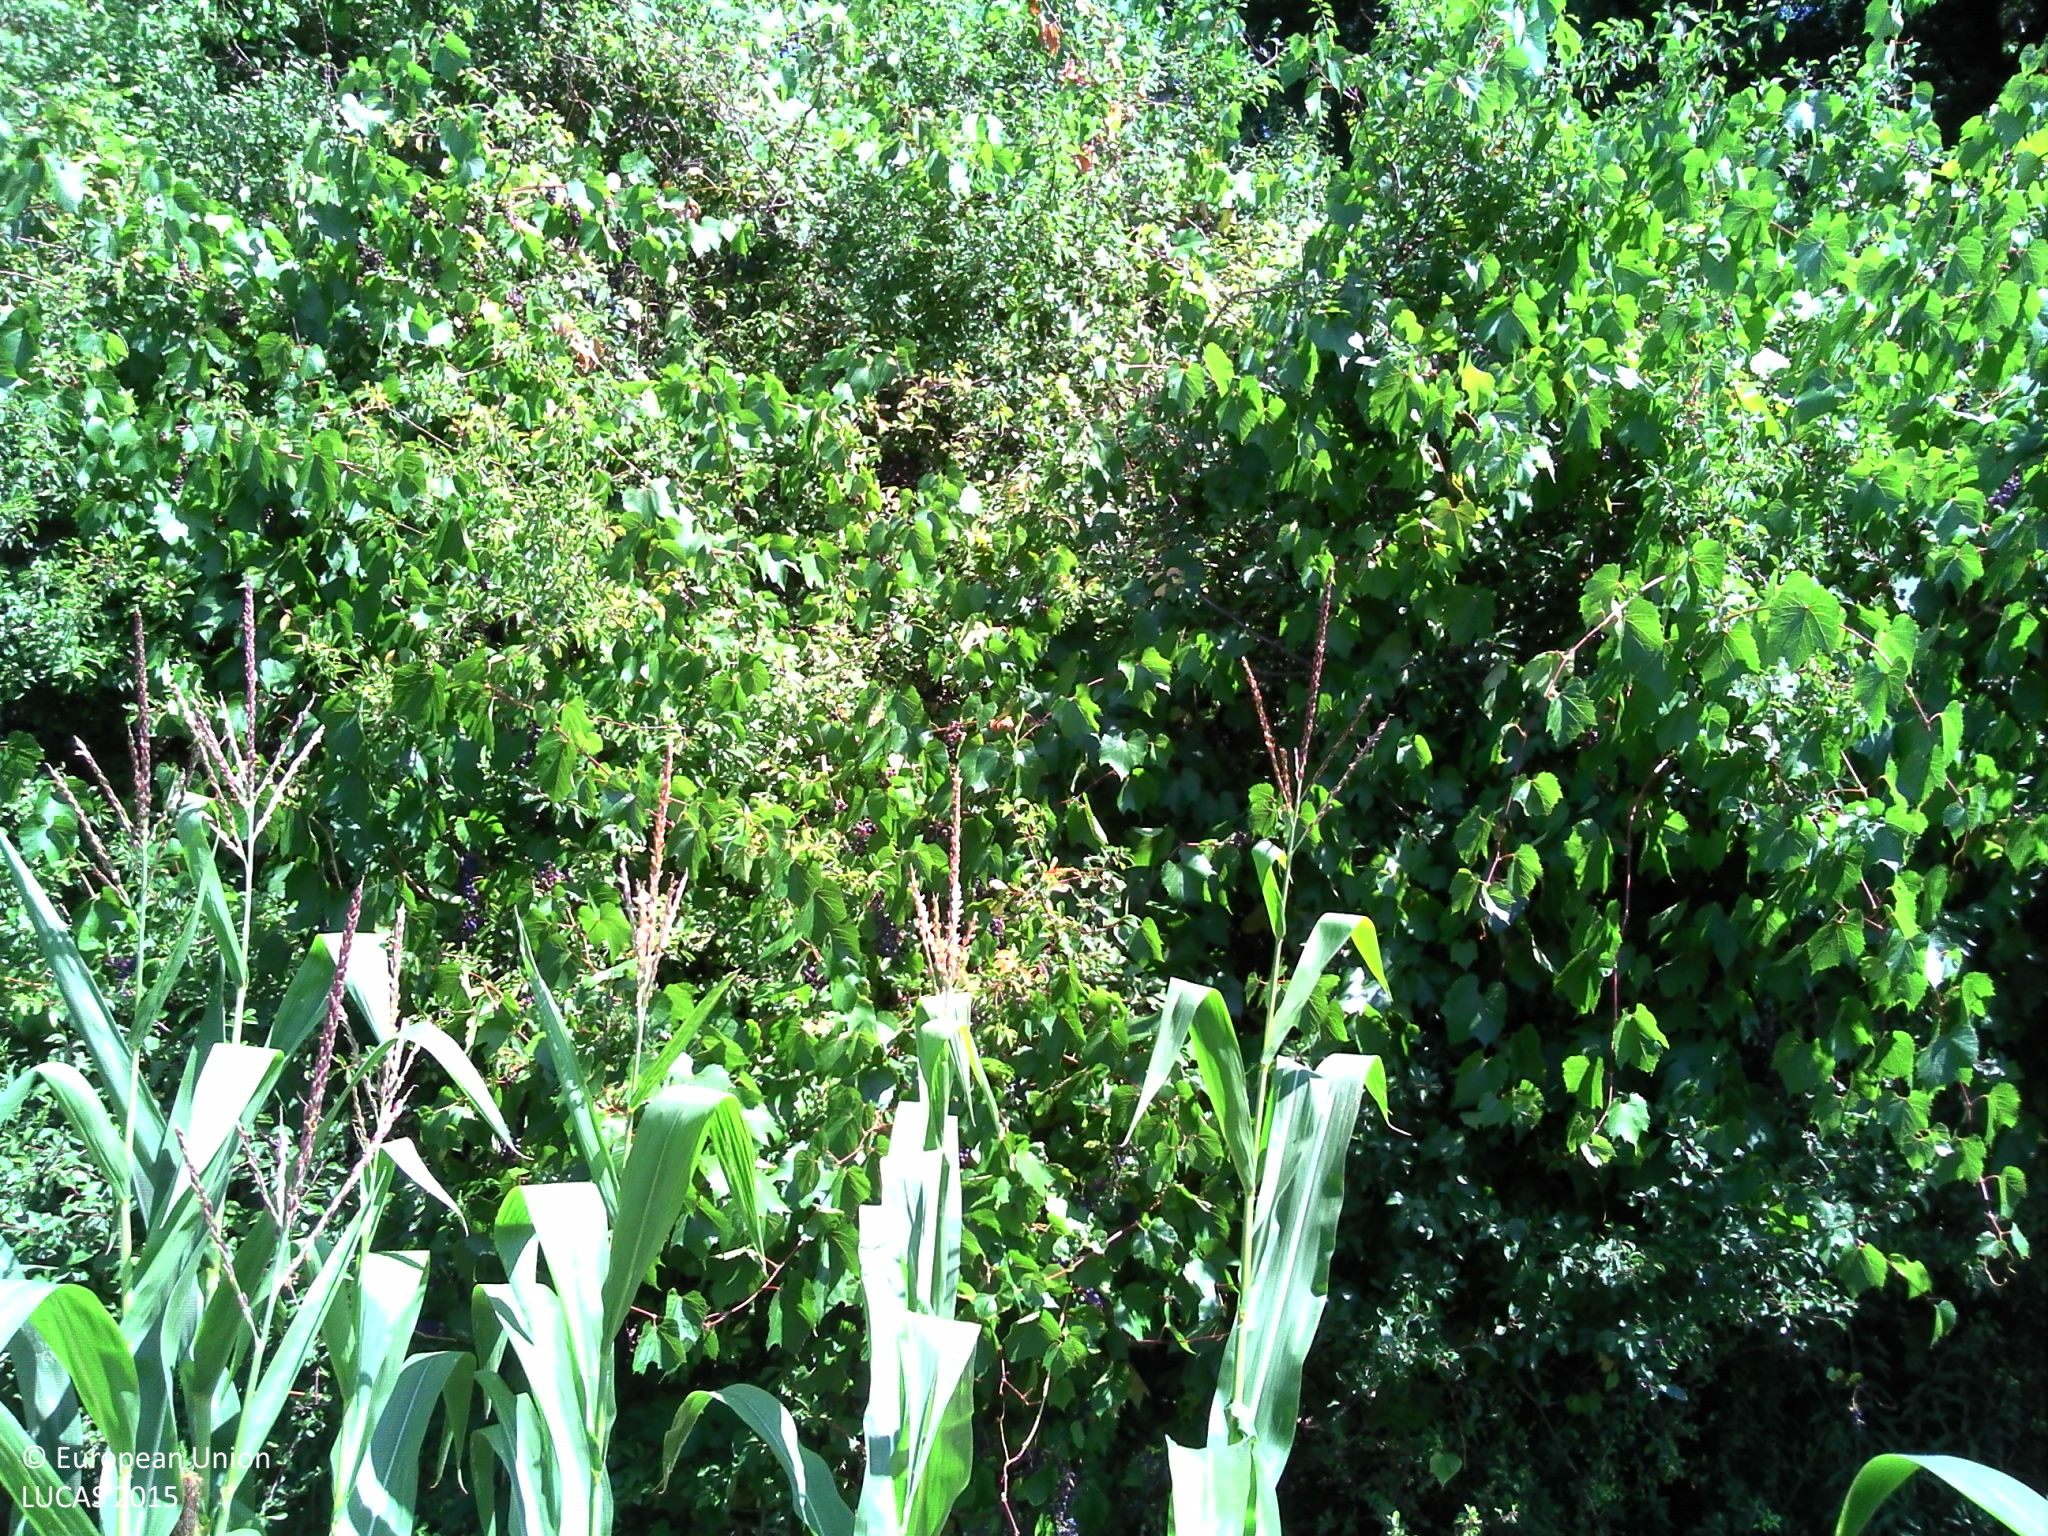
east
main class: Cropland
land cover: Maize
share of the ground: > 75 %
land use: Agriculture (excluding fallow land and kitchen gardens)
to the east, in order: Maize; Broadleaved woodland; Grass margins; Common wheat; Grass margins; Tracks; Grass margins; Maize
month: August
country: FR
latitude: 48.8178
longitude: 8.0259
